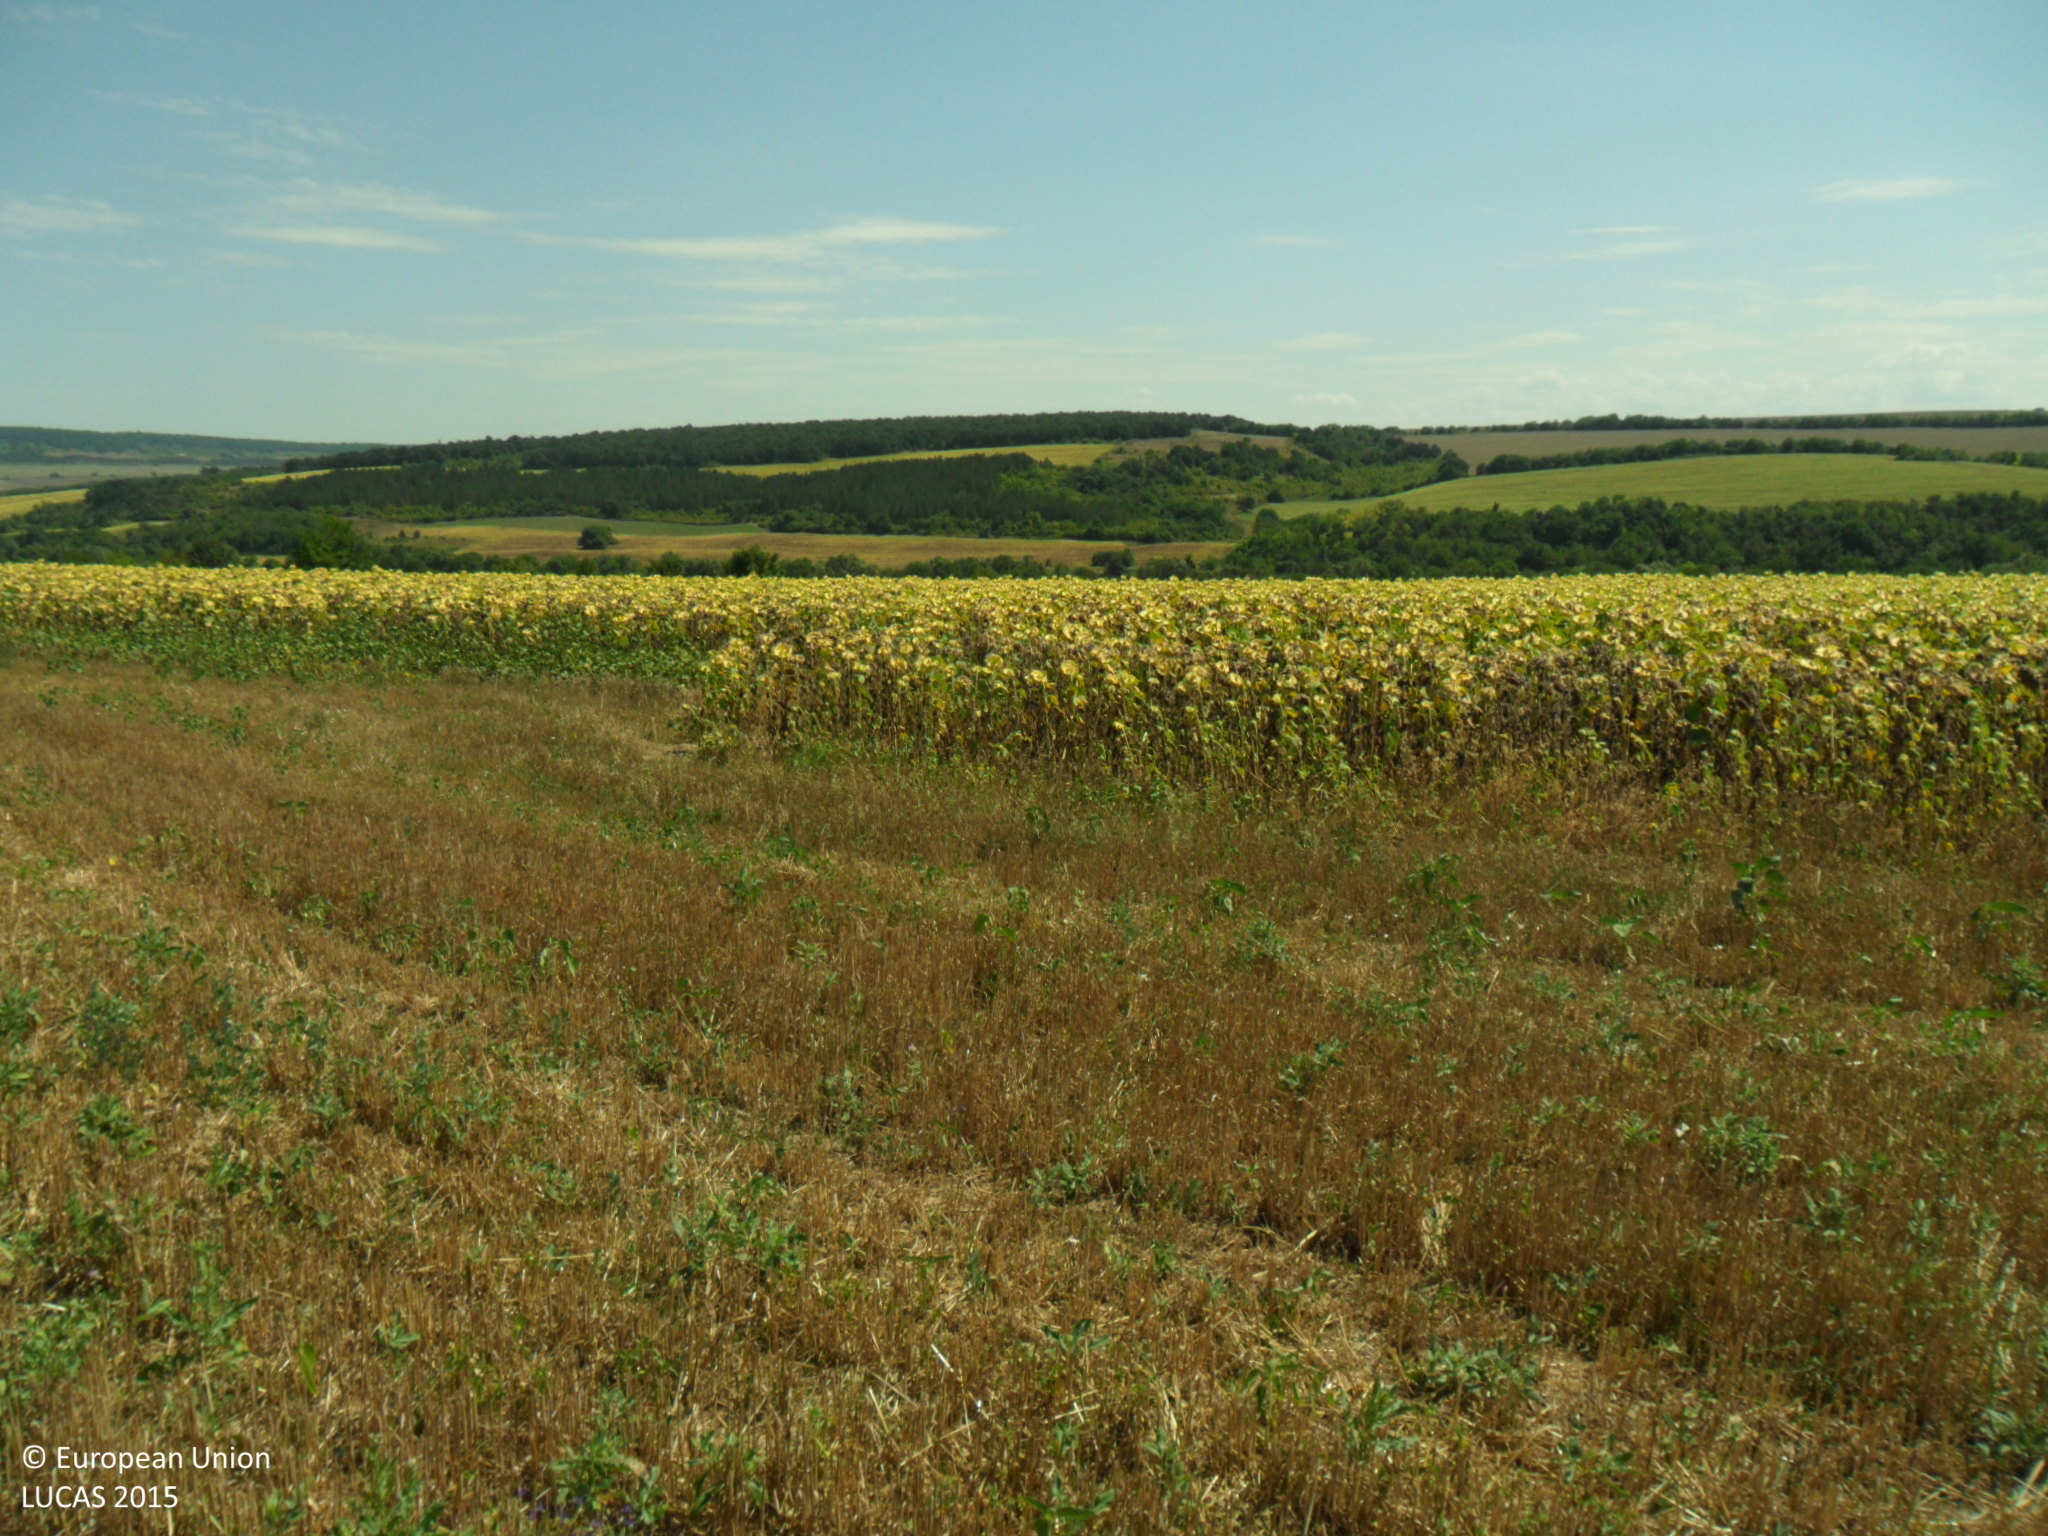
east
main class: Cropland
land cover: Common wheat
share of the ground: 25 - 50 %
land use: Agriculture (excluding fallow land and kitchen gardens)
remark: Harvested field
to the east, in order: Common wheat; Sunflower; Grass margins; Tracks; Grass margins; Lines of trees; Sunflower
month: August
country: BG
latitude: 43.5489
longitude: 26.4040
